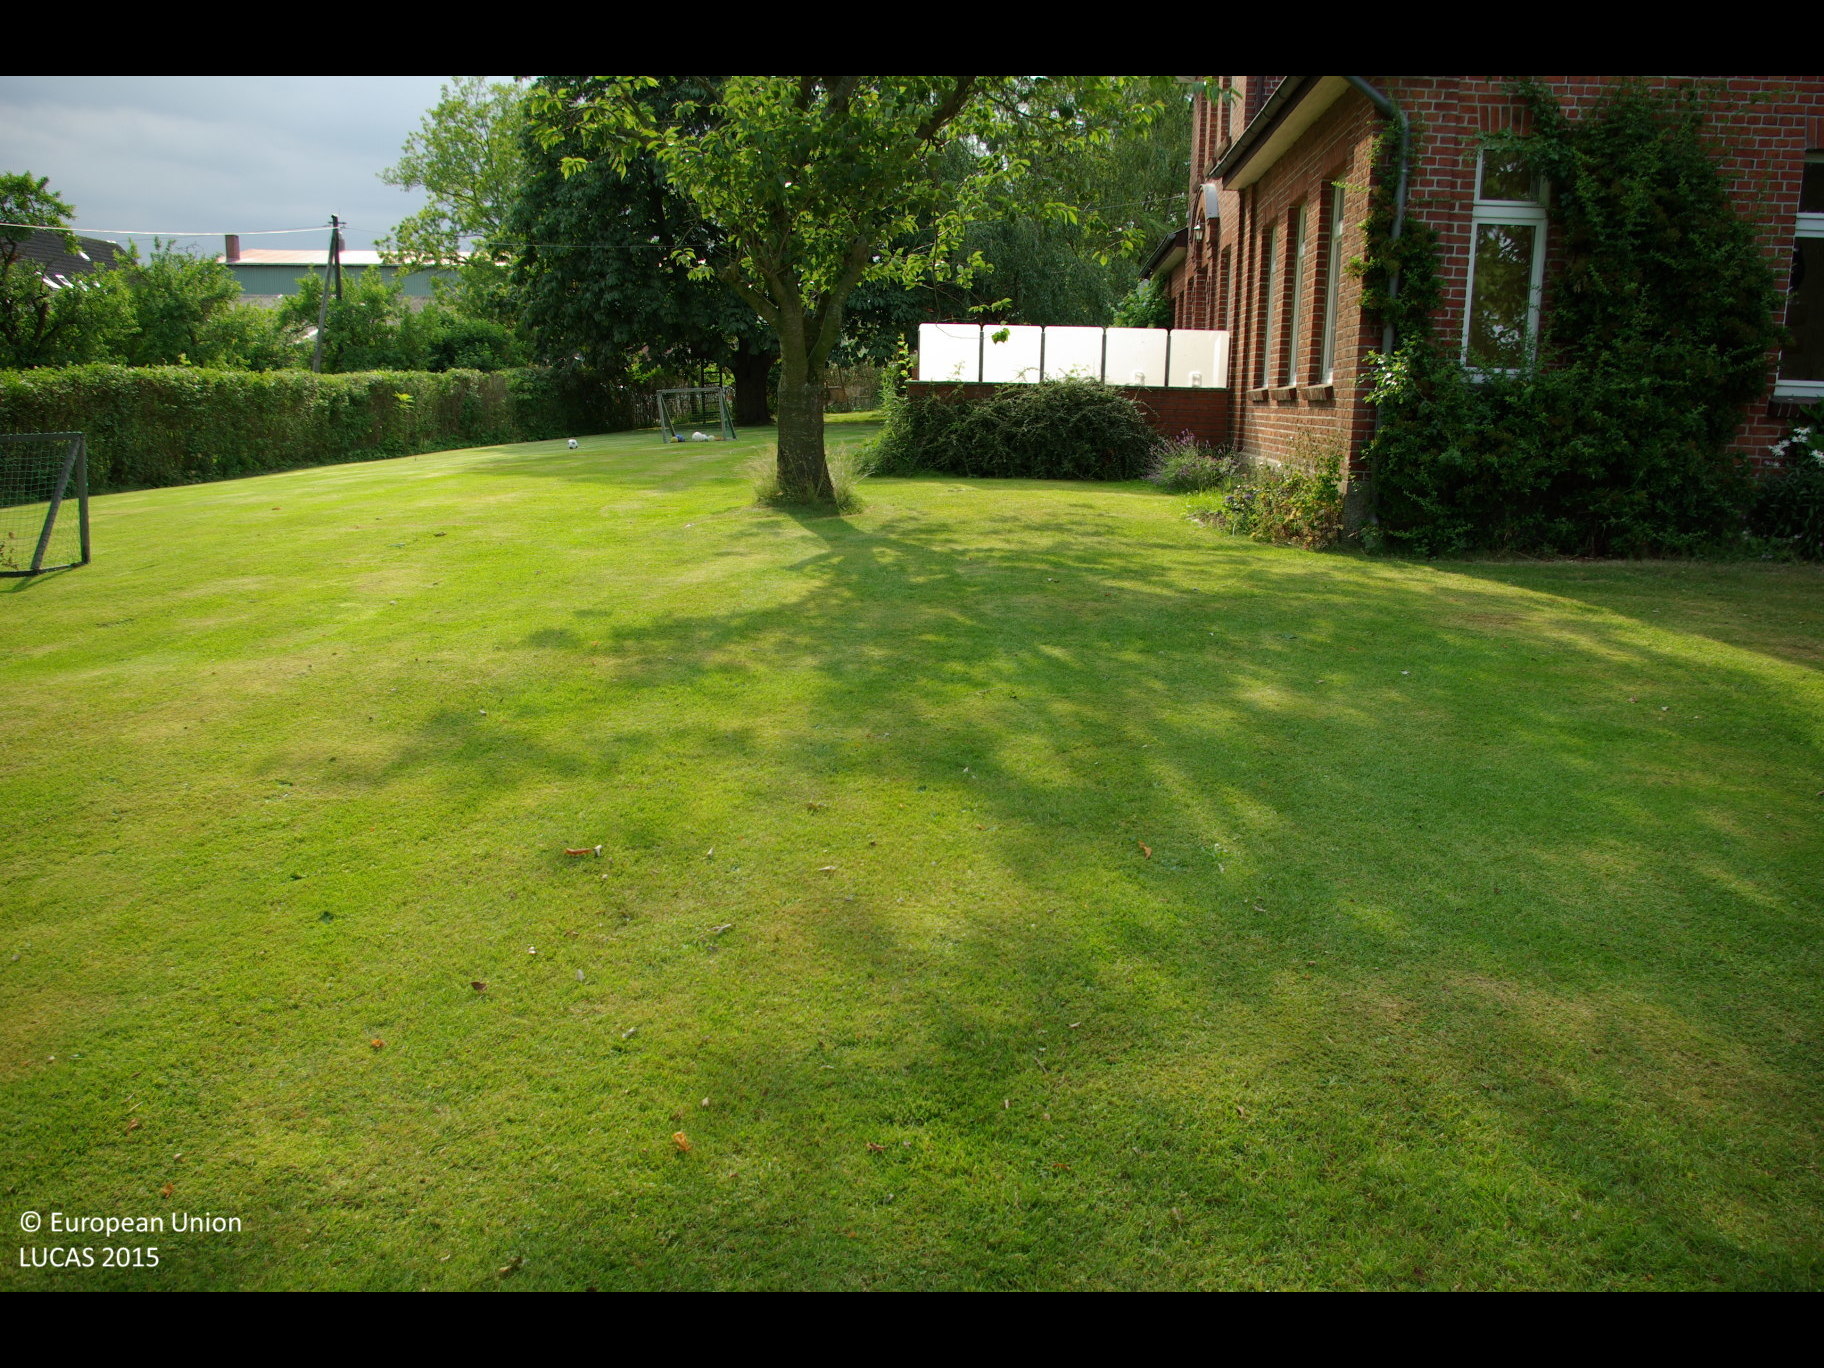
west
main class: Woodland
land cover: Broadleaved woodland
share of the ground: 50 - 75 %
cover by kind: broadleaved forest trees 50 %, herbaceous plants 50 %
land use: Residential
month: July
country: DE
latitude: 54.6779
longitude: 9.9225
